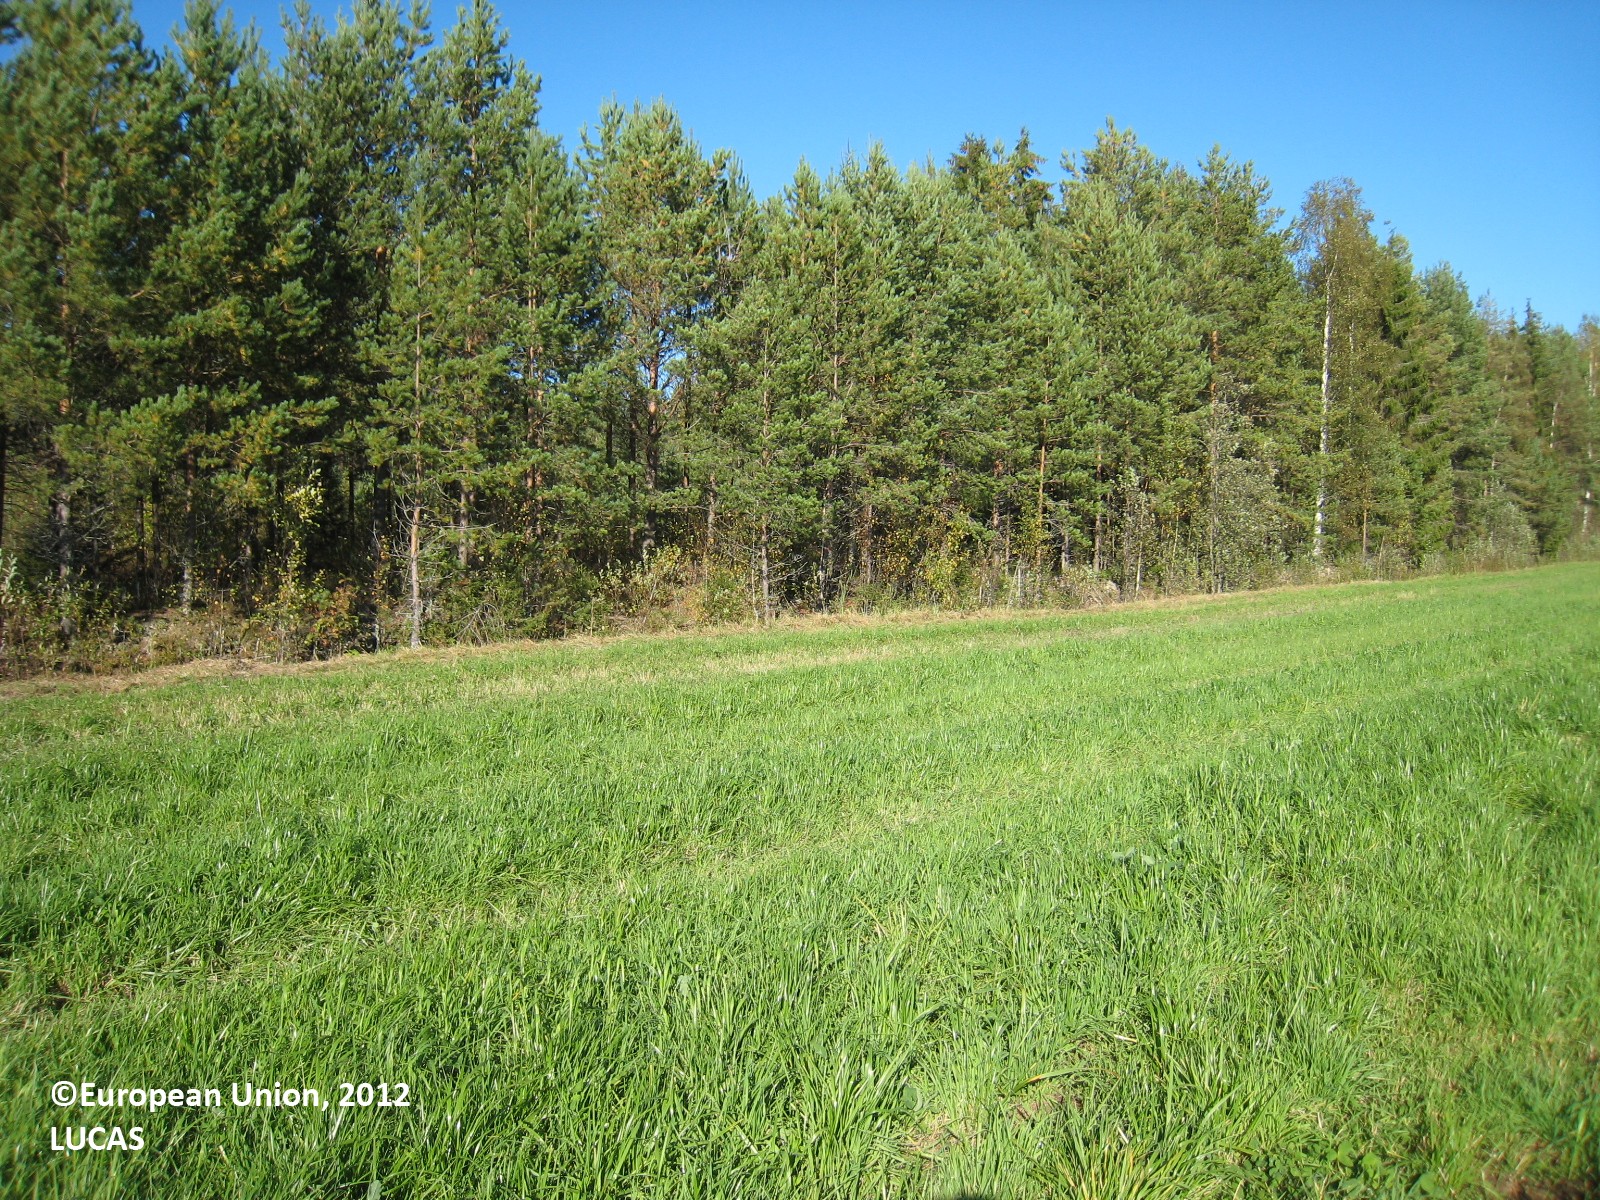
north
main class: Cropland
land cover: Temporary grasslands
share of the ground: > 75 %
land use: Agriculture (excluding fallow land and kitchen gardens)
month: September
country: FI
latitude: 62.7845
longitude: 26.6614
